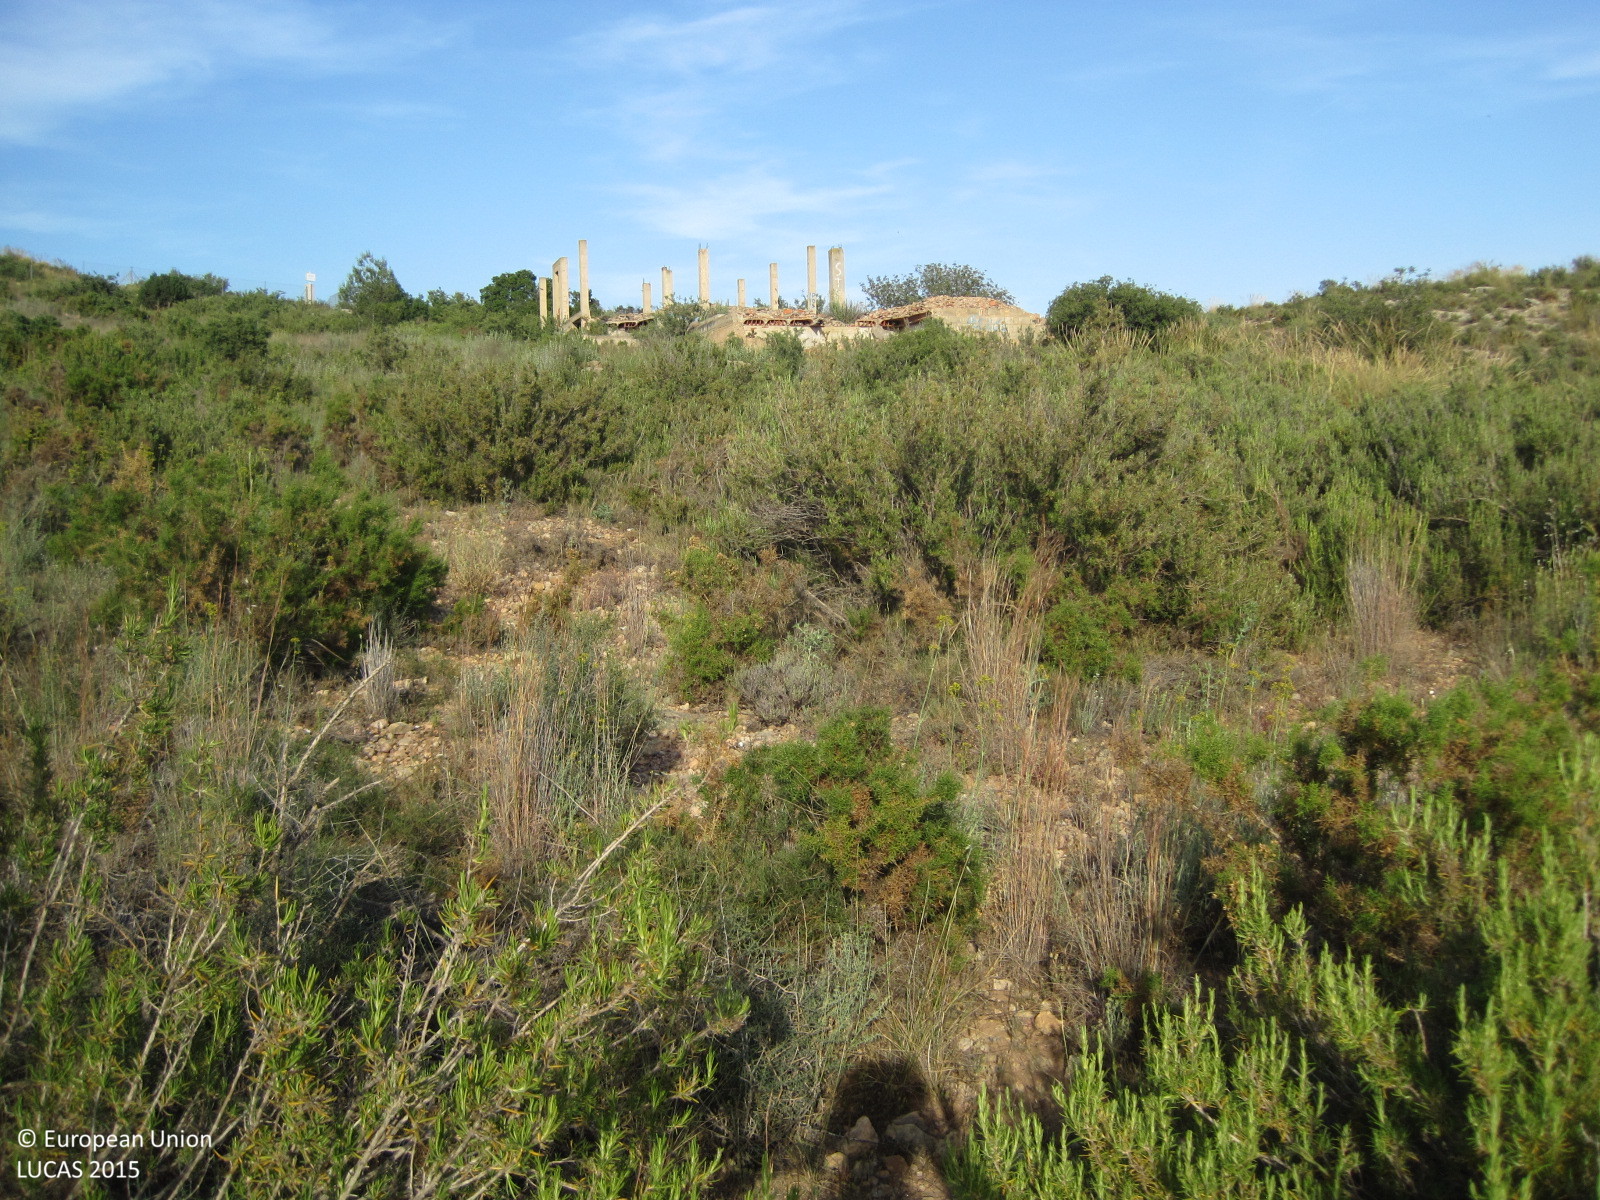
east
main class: Shrubland
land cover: Shrubland without tree cover
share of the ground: > 75 %
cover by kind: shrubs 80 %, consolidated bare surface 15 %, herbaceous plants 5 %
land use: Semi-natural and natural areas not in use
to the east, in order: Shrubland without tree cover; Tracks; Shrubland without tree cover; Tracks; Shrubland with sparse tree cover; Artificial constructions in urban areas; Shrubland with sparse tree cover
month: May
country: ES
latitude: 39.6838
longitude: -0.6696
